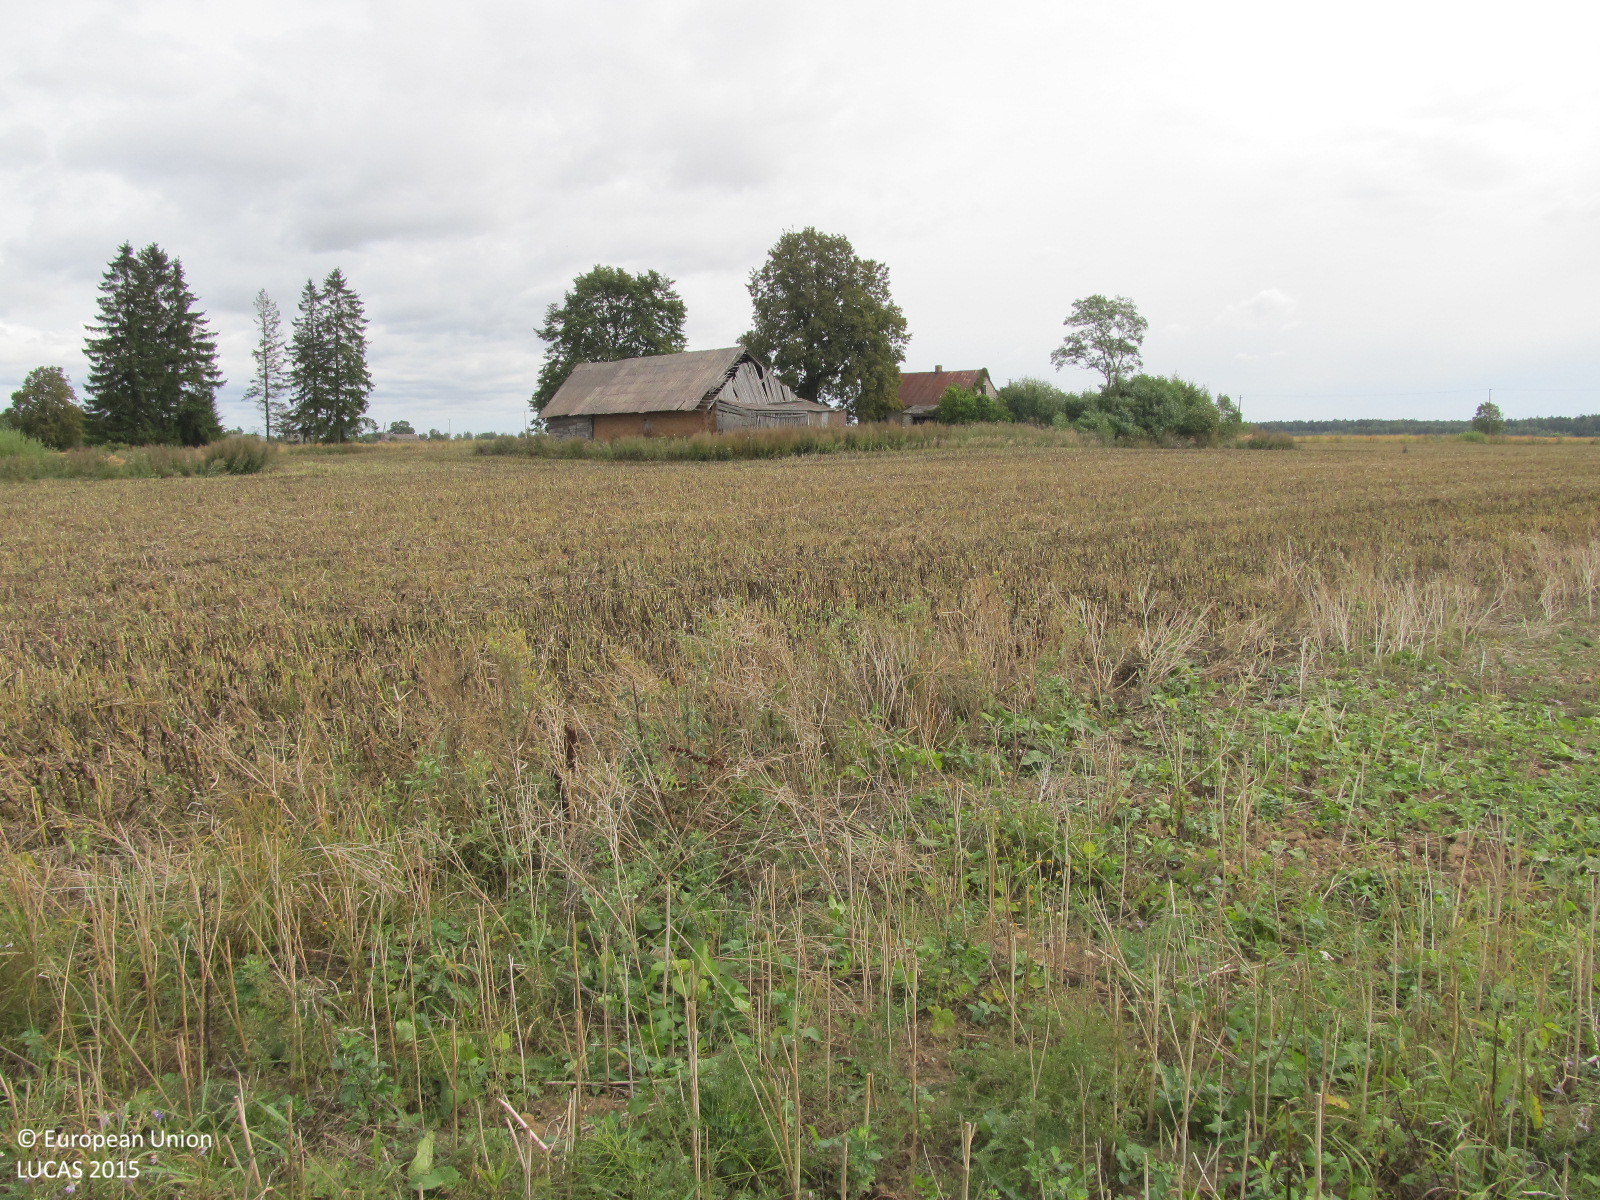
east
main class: Cropland
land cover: Rape and turnip rape
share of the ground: 50 - 75 %
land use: Agriculture (excluding fallow land and kitchen gardens)
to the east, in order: Rape and turnip rape; Grassland with sparse tree/shrub cover; Ditches and canals; Grassland with sparse tree/shrub cover; Rape and turnip rape; Dry pulses; Spontaneously vegetated surfaces; Artificial constructions in urban areas; Spontaneously vegetated surfaces; Dry pulses; Grass margins; Tracks; Grass margins; Barley
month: September
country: LT
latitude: 56.2763
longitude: 23.2993
